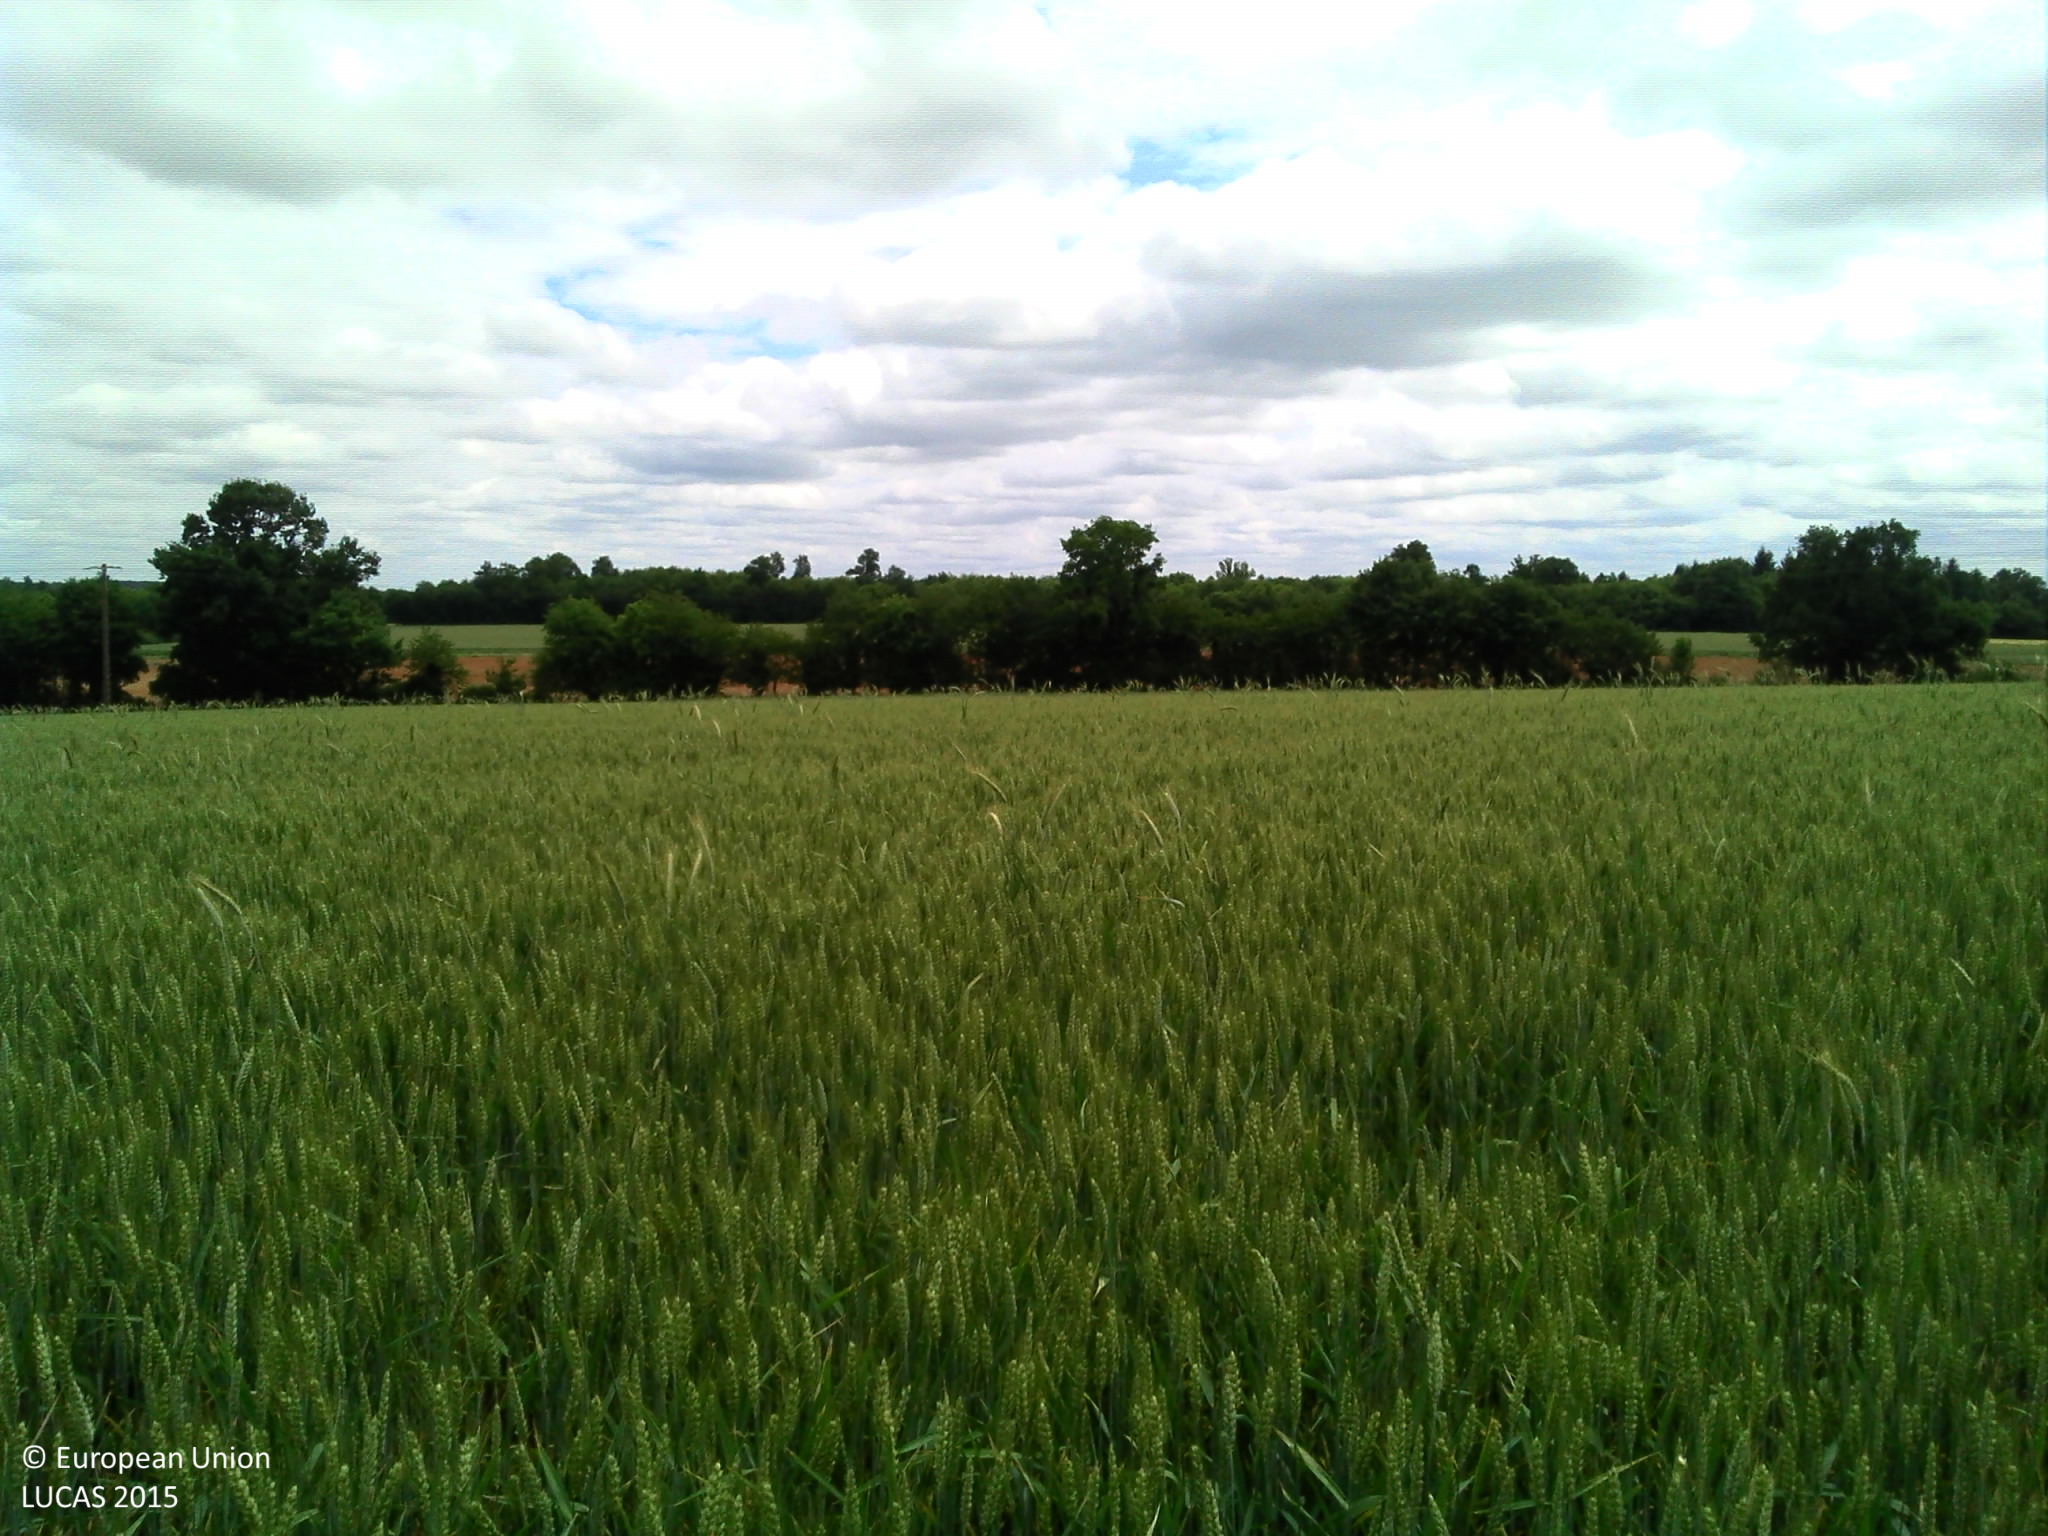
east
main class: Cropland
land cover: Common wheat
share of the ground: > 75 %
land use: Agriculture (excluding fallow land and kitchen gardens)
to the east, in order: Common wheat; Electric lines; Common wheat; Managed hedges; Ditches and canals; Sunflower
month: June
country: FR
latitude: 46.0058
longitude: 0.3628
